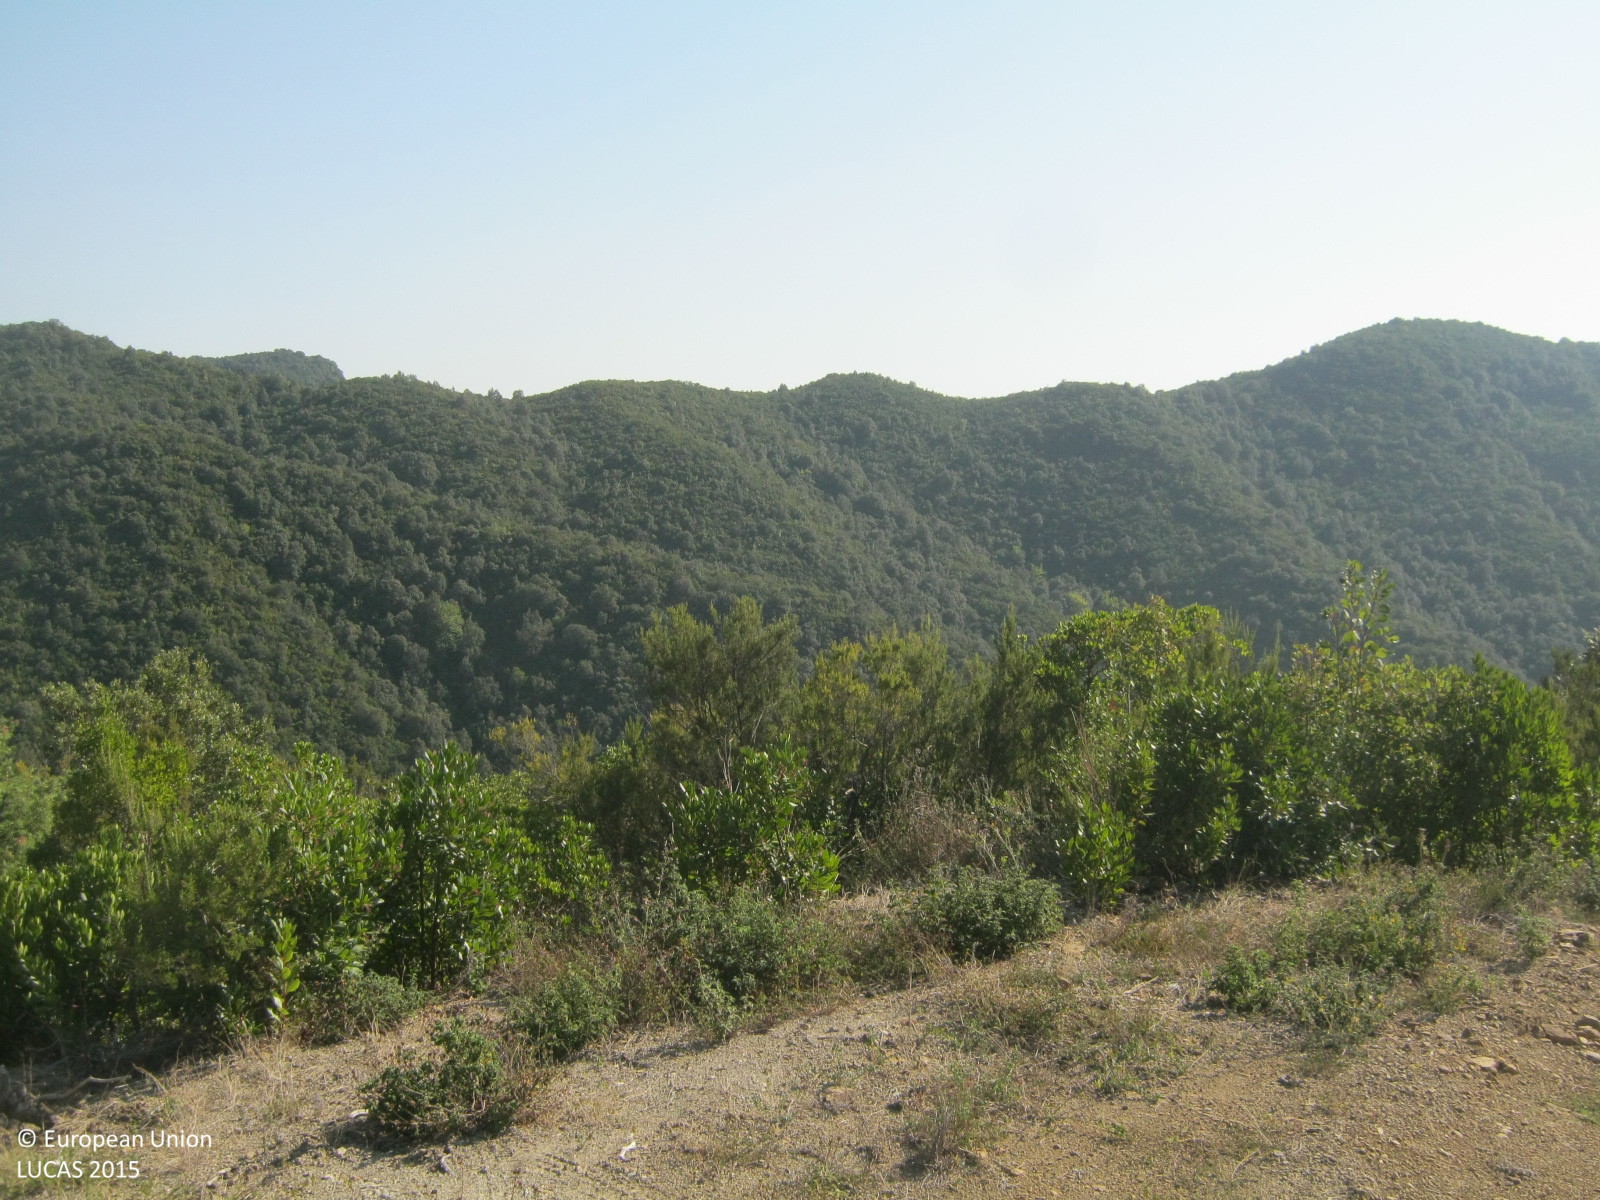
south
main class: Woodland
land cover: Broadleaved woodland
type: broadleaved evergreen forest
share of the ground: 50 - 75 %
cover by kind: broadleaved forest trees 50 %, shrubs 50 %
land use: Semi-natural and natural areas not in use
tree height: > 5 m
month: September
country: GR
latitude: 39.3198
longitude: 21.1463
